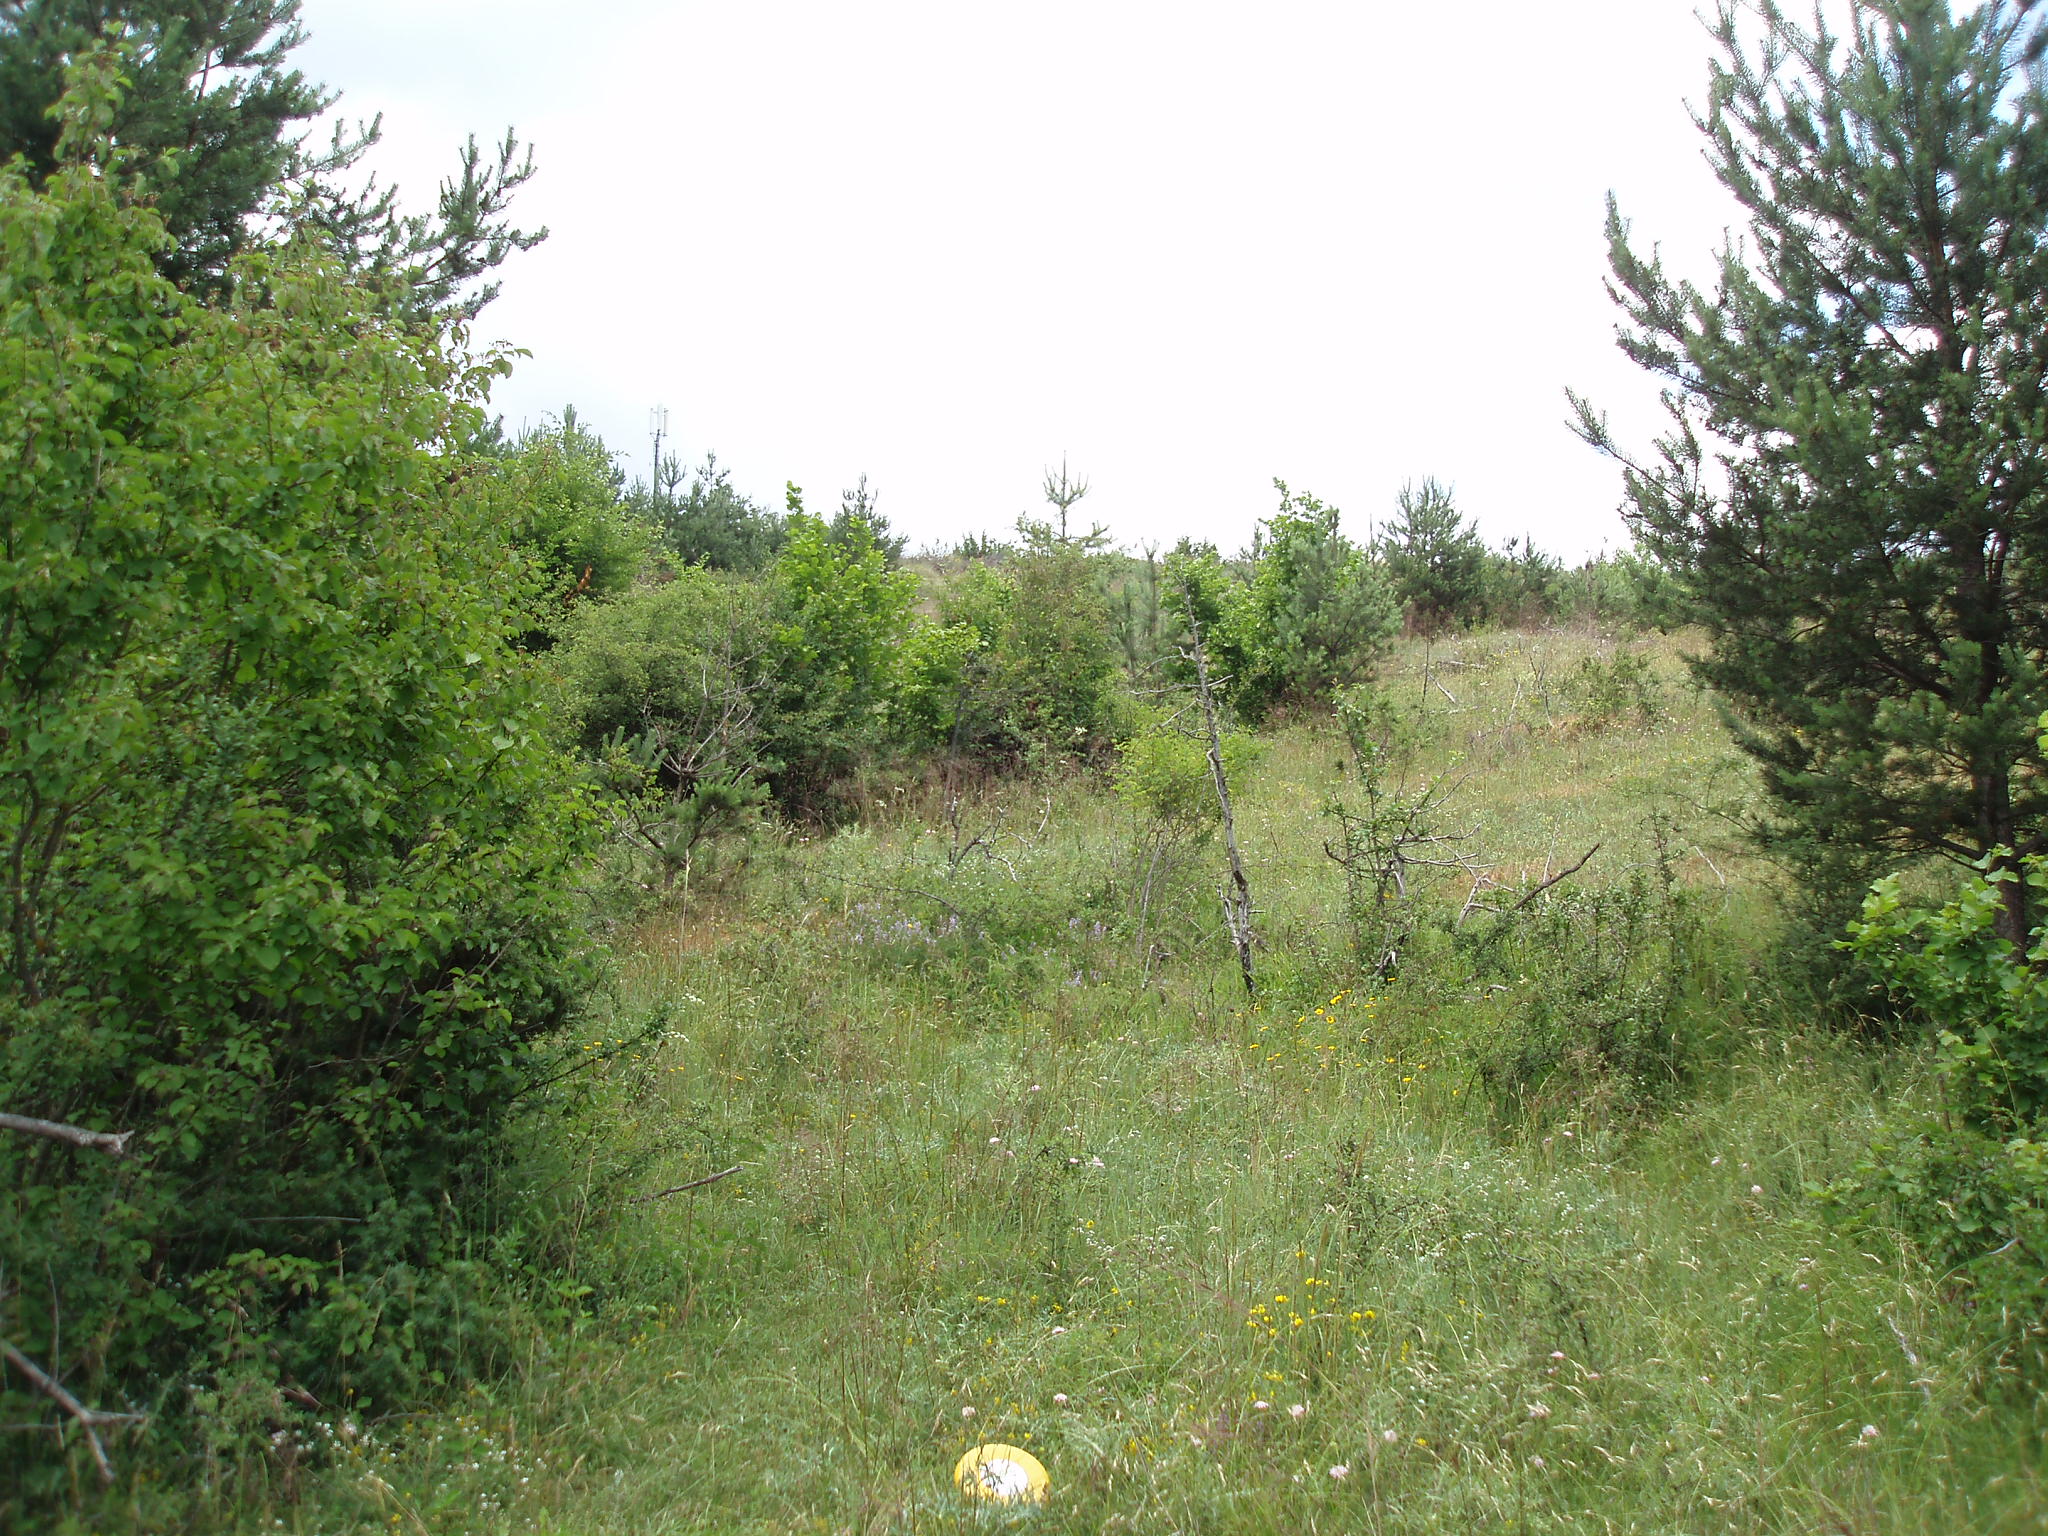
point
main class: Grassland
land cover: Grassland with sparse tree/shrub cover
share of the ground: > 75 %
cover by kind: herbaceous plants 90 %, broadleaved forest trees 5 %, shrubs 5 %
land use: Agriculture (excluding fallow land and kitchen gardens)
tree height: > 5 m
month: July
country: BG
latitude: 41.9108
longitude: 23.4951
